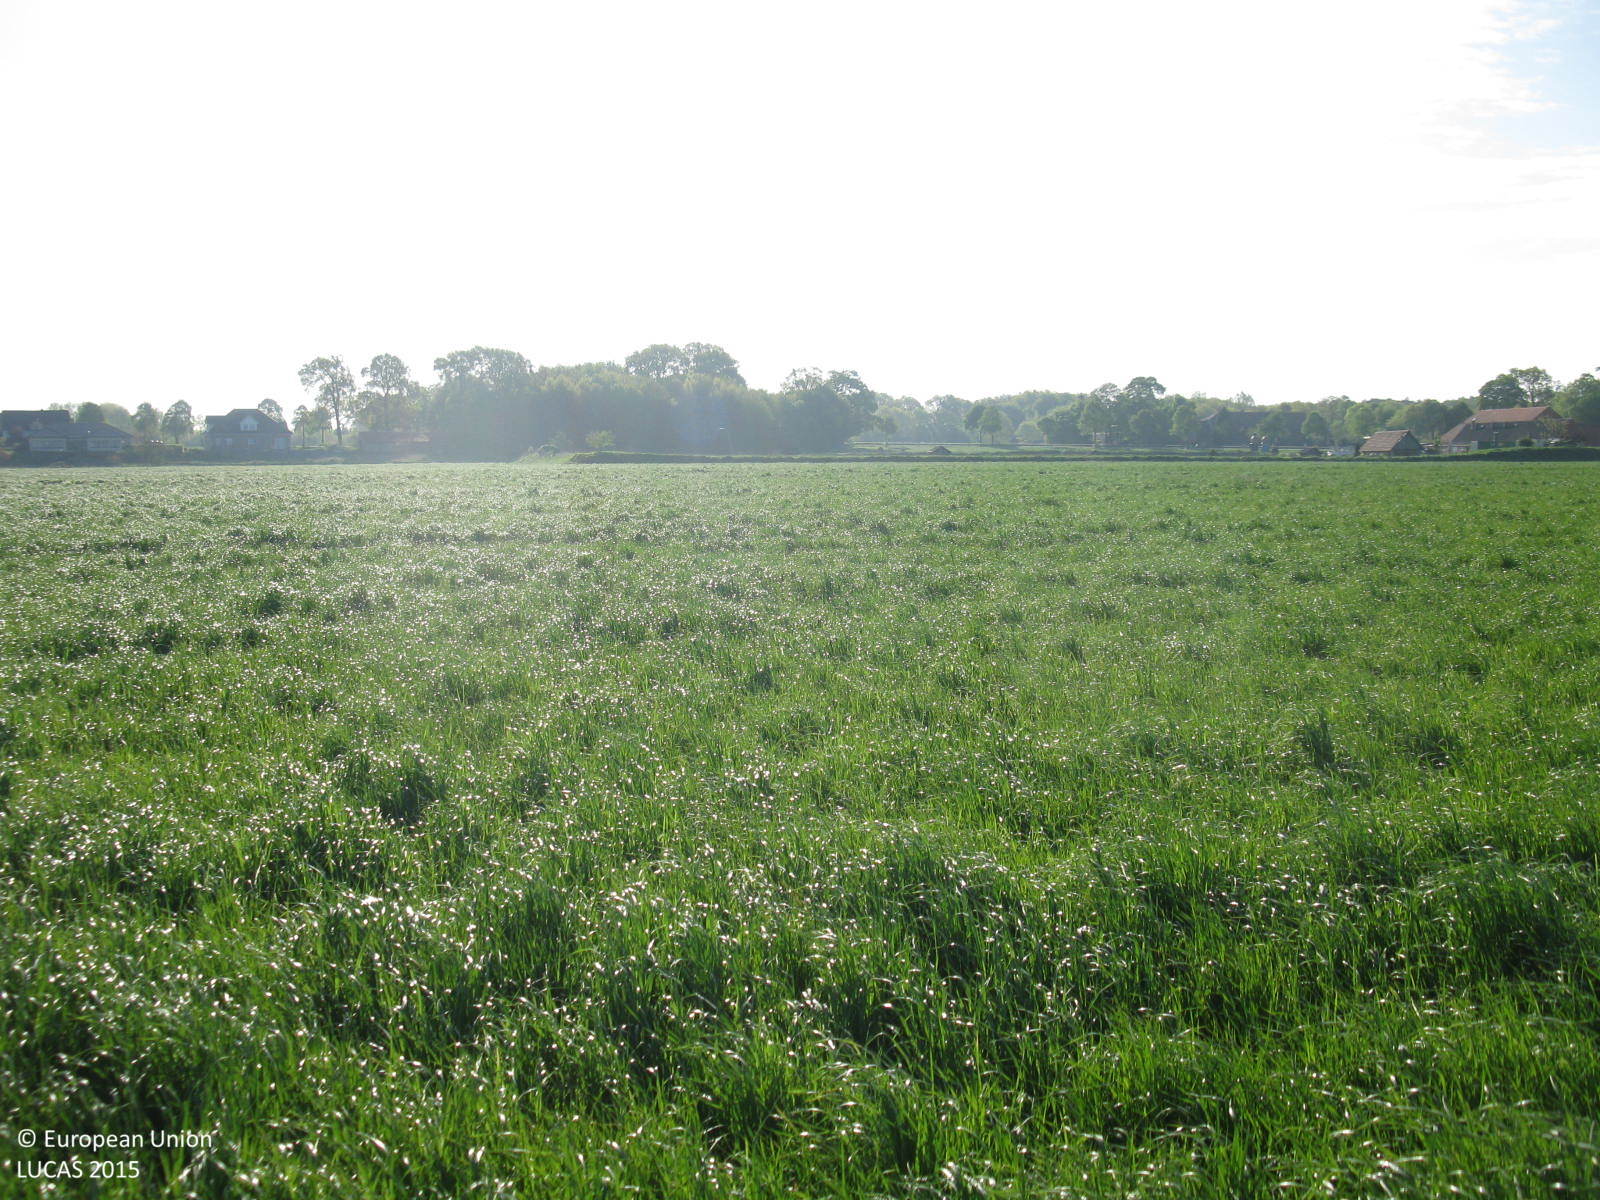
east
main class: Grassland
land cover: Grassland without tree/shrub cover
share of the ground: > 75 %
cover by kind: herbaceous plants 100 %
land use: Agriculture (excluding fallow land and kitchen gardens)
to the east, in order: Grassland without tree/shrub cover; Spontaneously vegetated surfaces; Grassland without tree/shrub cover
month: May
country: DE
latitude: 52.8506
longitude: 7.3127
